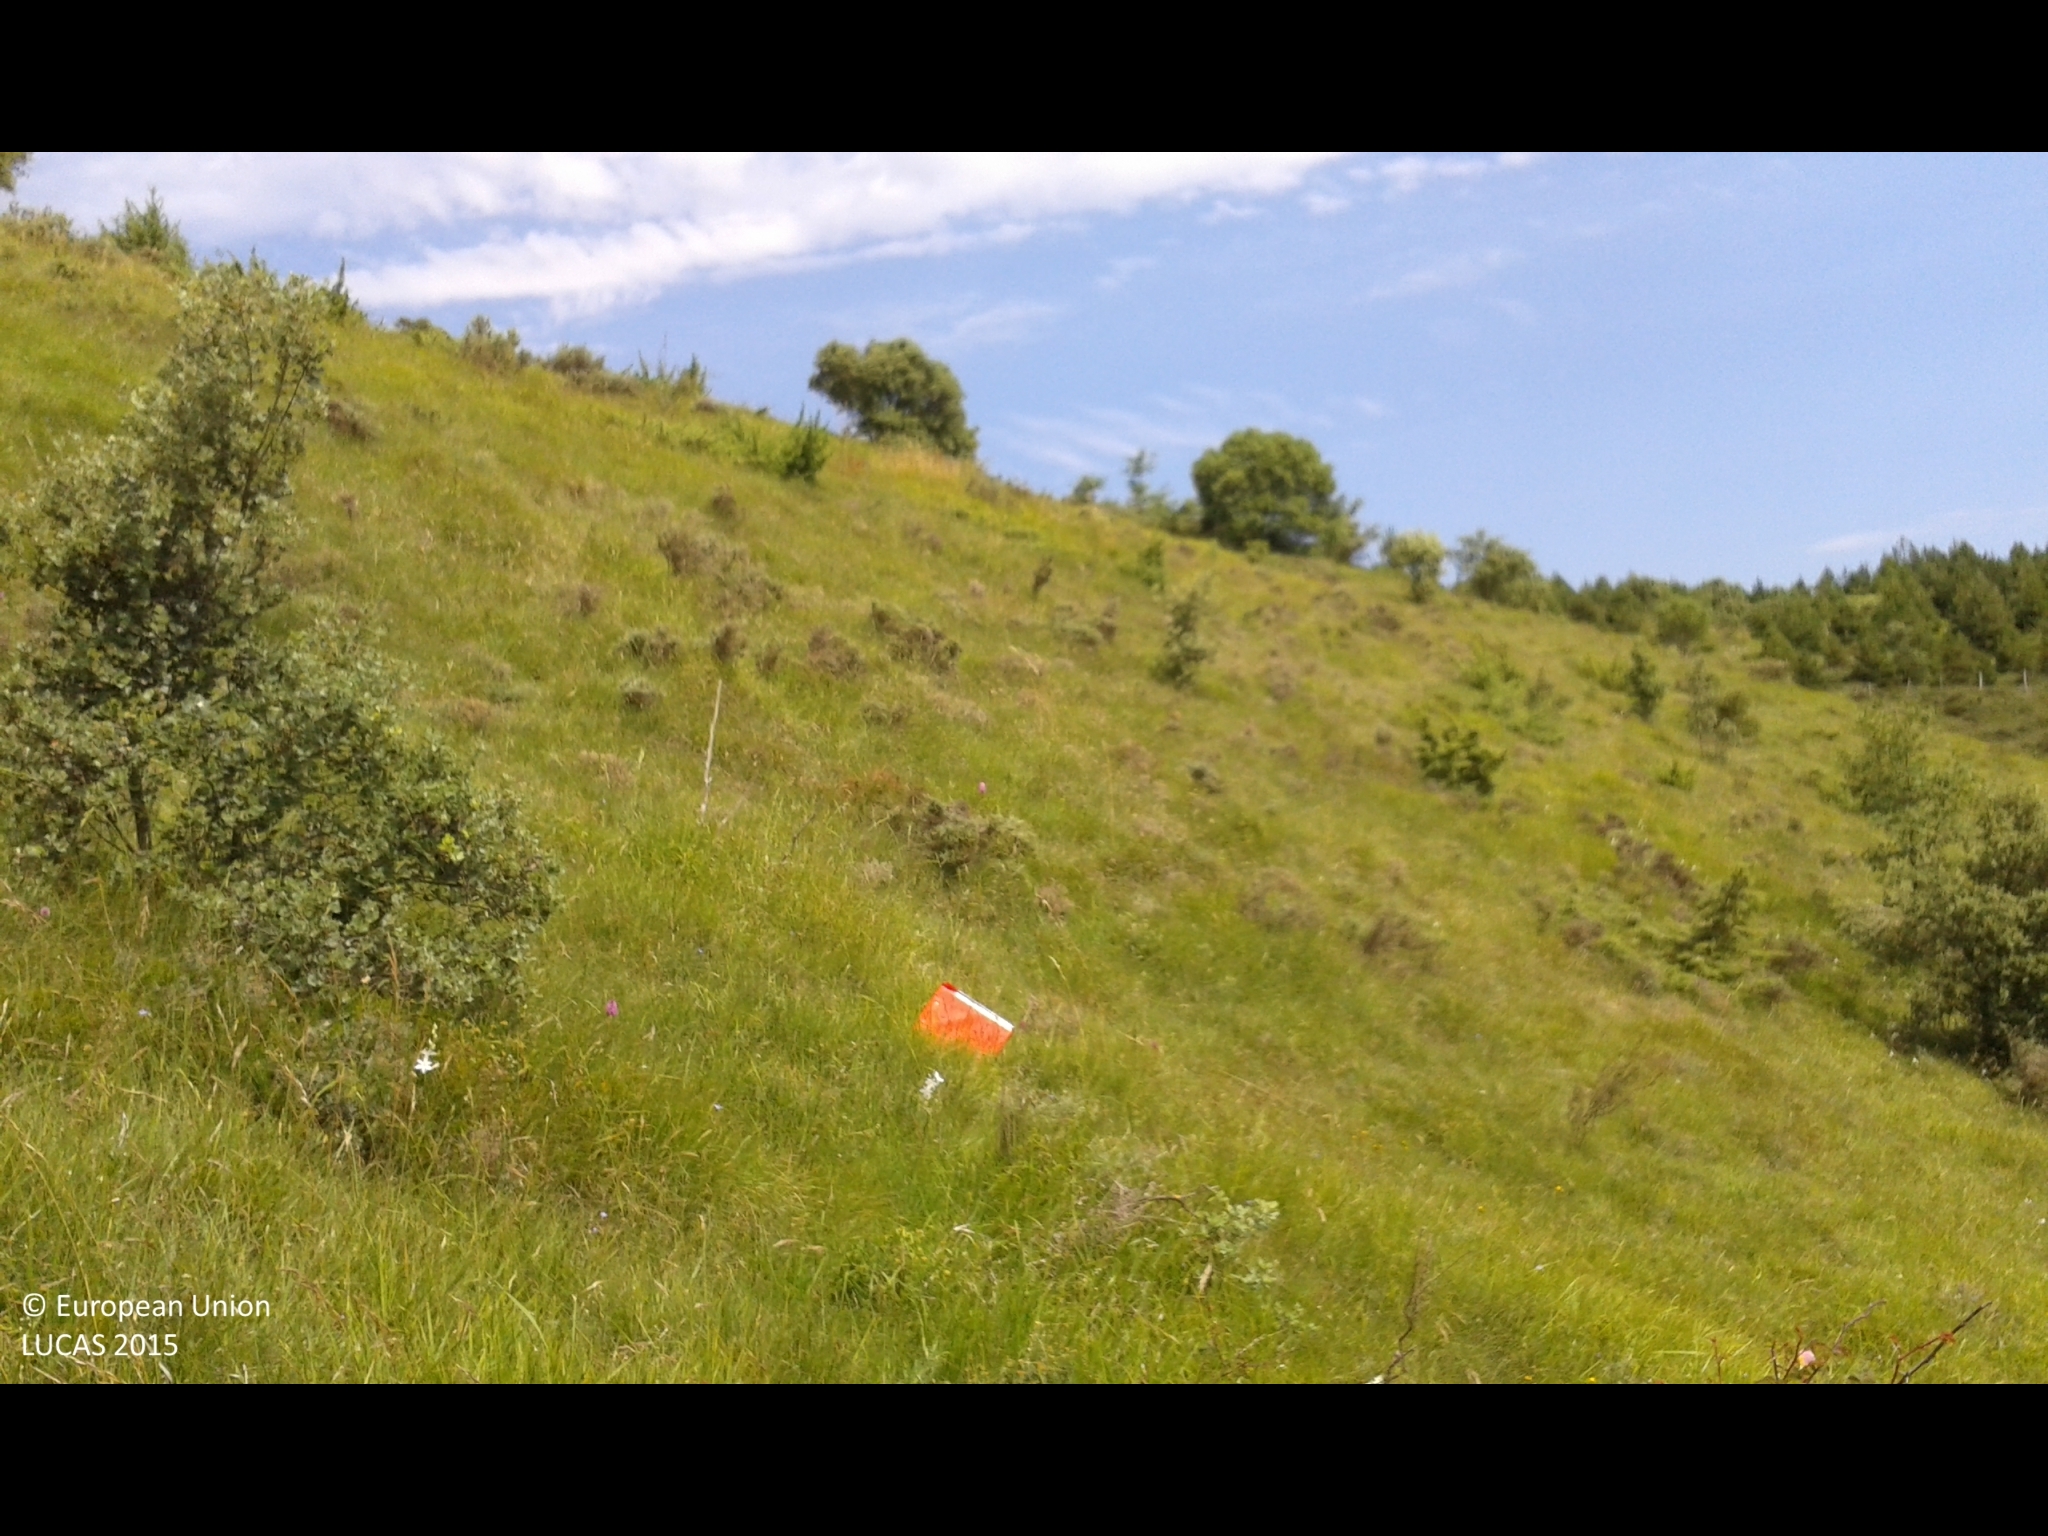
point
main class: Shrubland
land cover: Shrubland with sparse tree cover
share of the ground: > 75 %
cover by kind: herbaceous plants 75 %, shrubs 20 %, broadleaved forest trees 5 %
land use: Agriculture (excluding fallow land and kitchen gardens)
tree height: < 5 m
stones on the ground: < 10 %
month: June
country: ES
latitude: 42.8838
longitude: -1.7086
